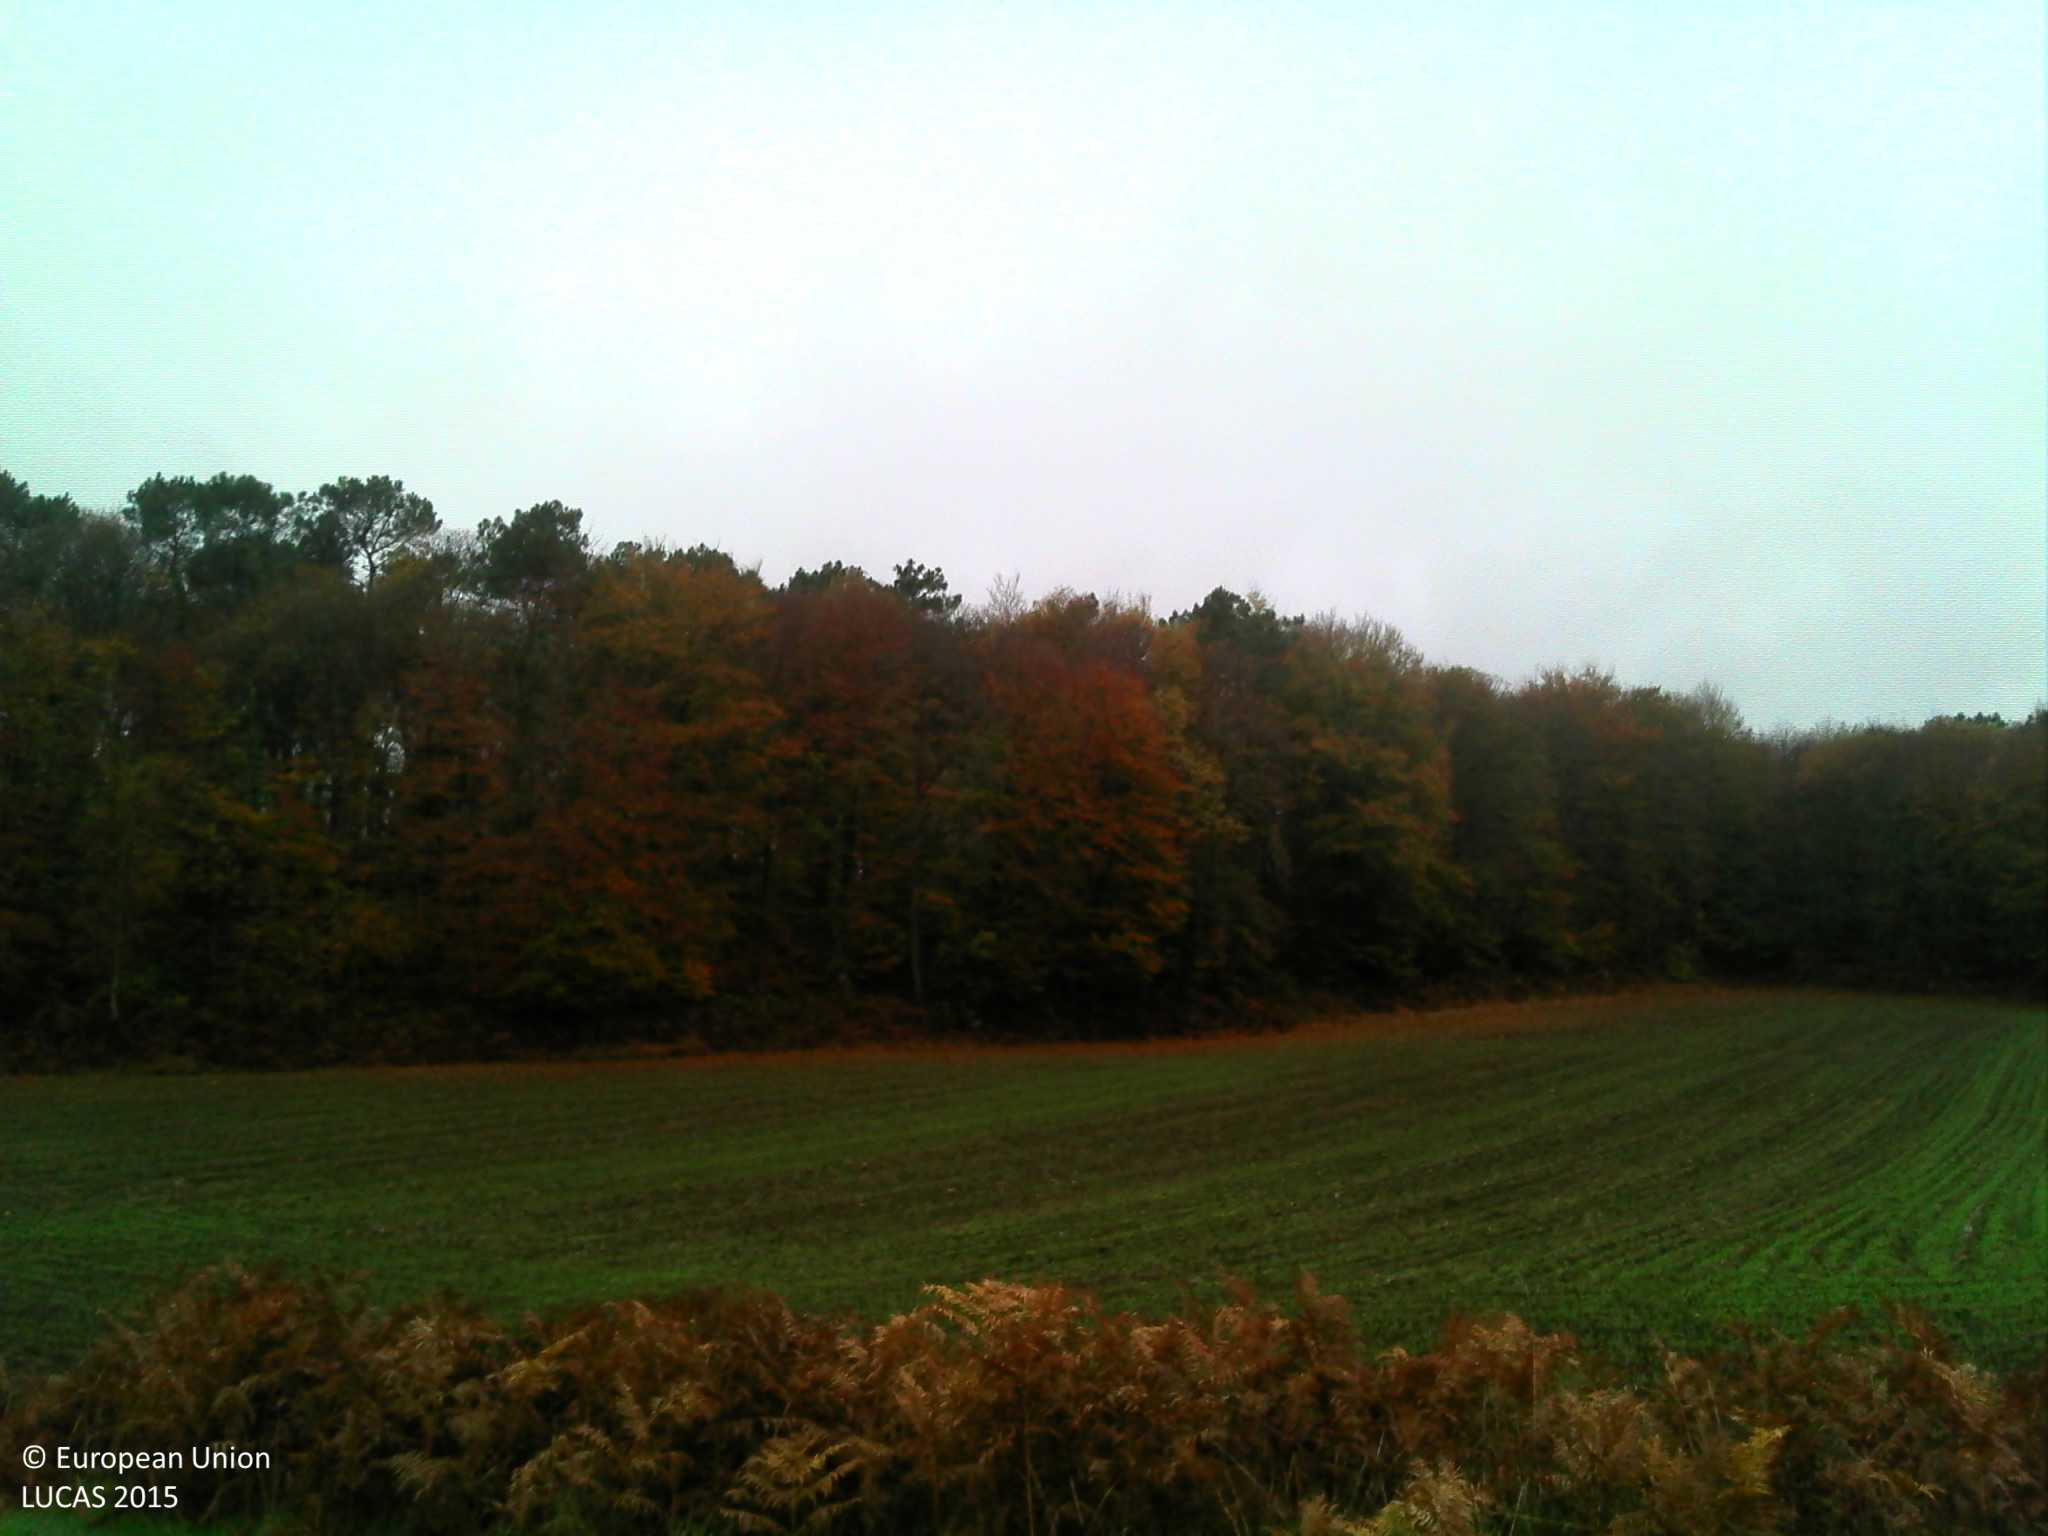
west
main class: Cropland
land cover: Maize
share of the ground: > 75 %
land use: Agriculture (excluding fallow land and kitchen gardens)
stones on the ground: < 10 %
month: November
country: FR
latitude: 47.9437
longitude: -3.2865
